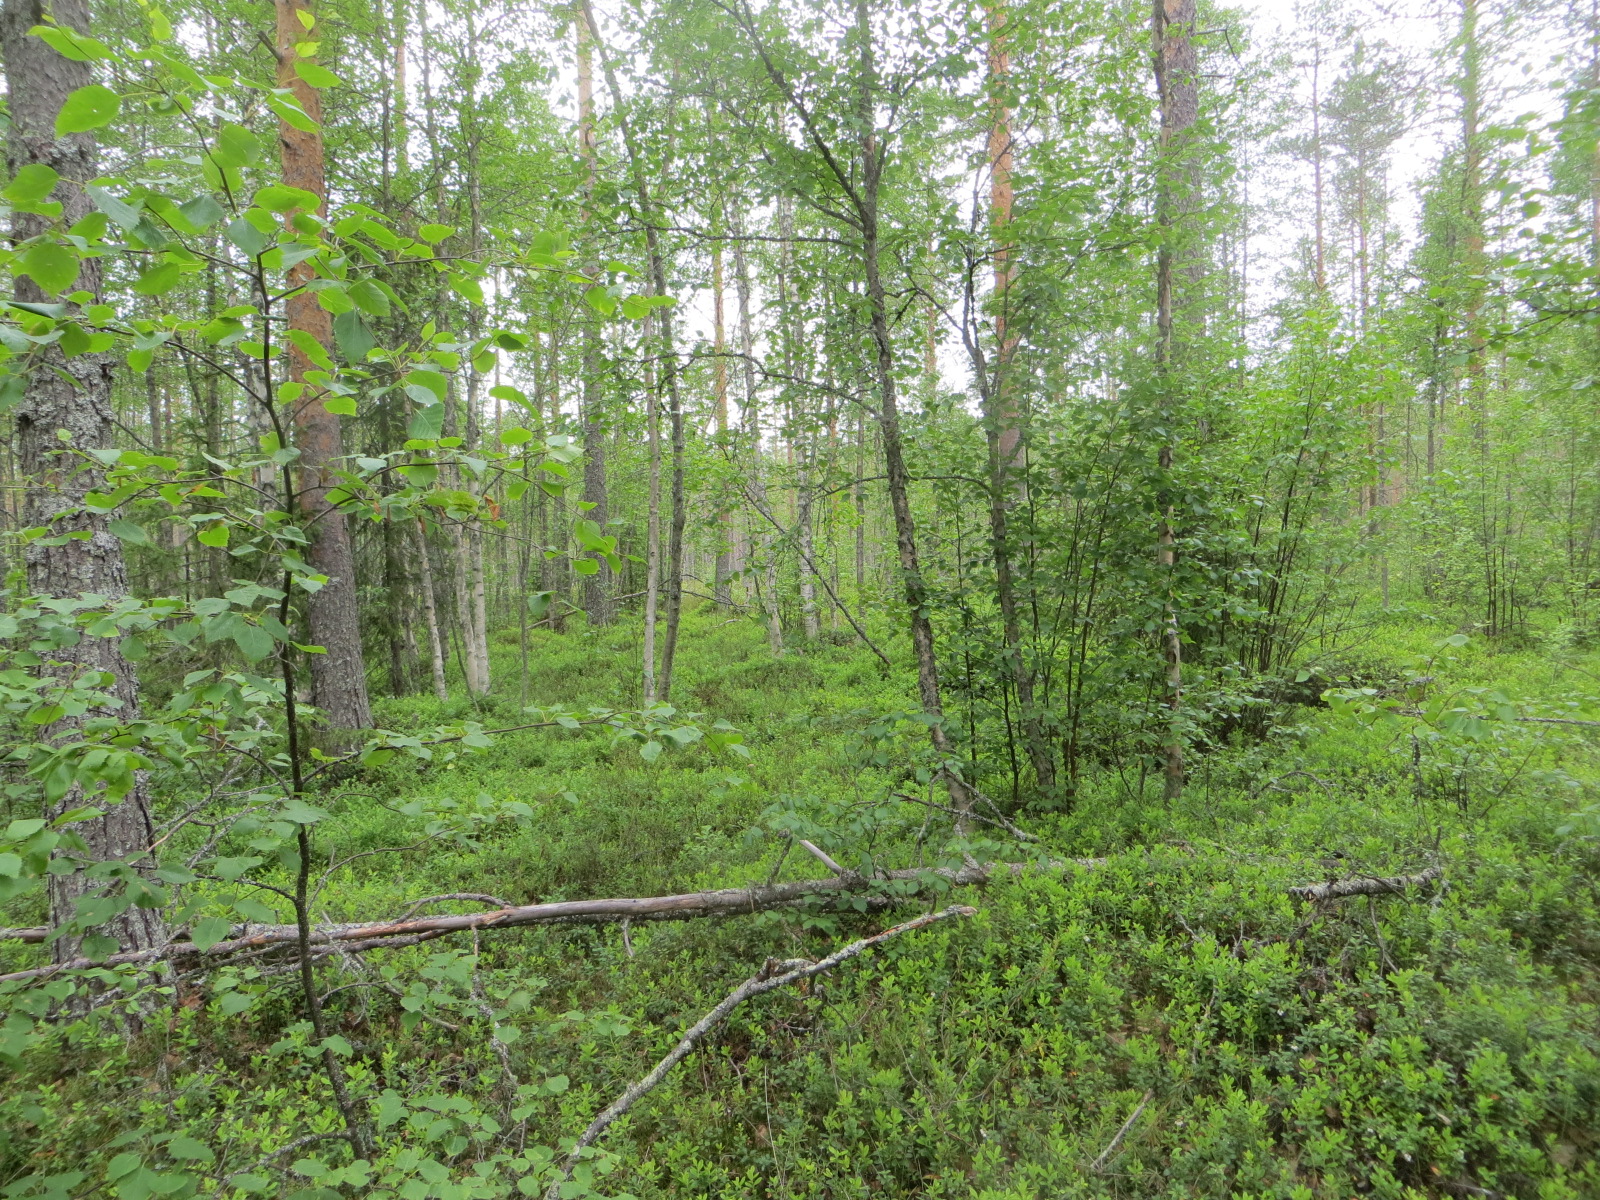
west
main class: Woodland
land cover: Pine dominated mixed woodland
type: boreal forest
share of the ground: 50 - 75 %
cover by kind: coniferous forest trees 50 %, shrubs 30 %, broadleaved forest trees 20 %
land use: Forestry
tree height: > 5 m
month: July
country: FI
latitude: 65.4726
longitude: 25.9559
